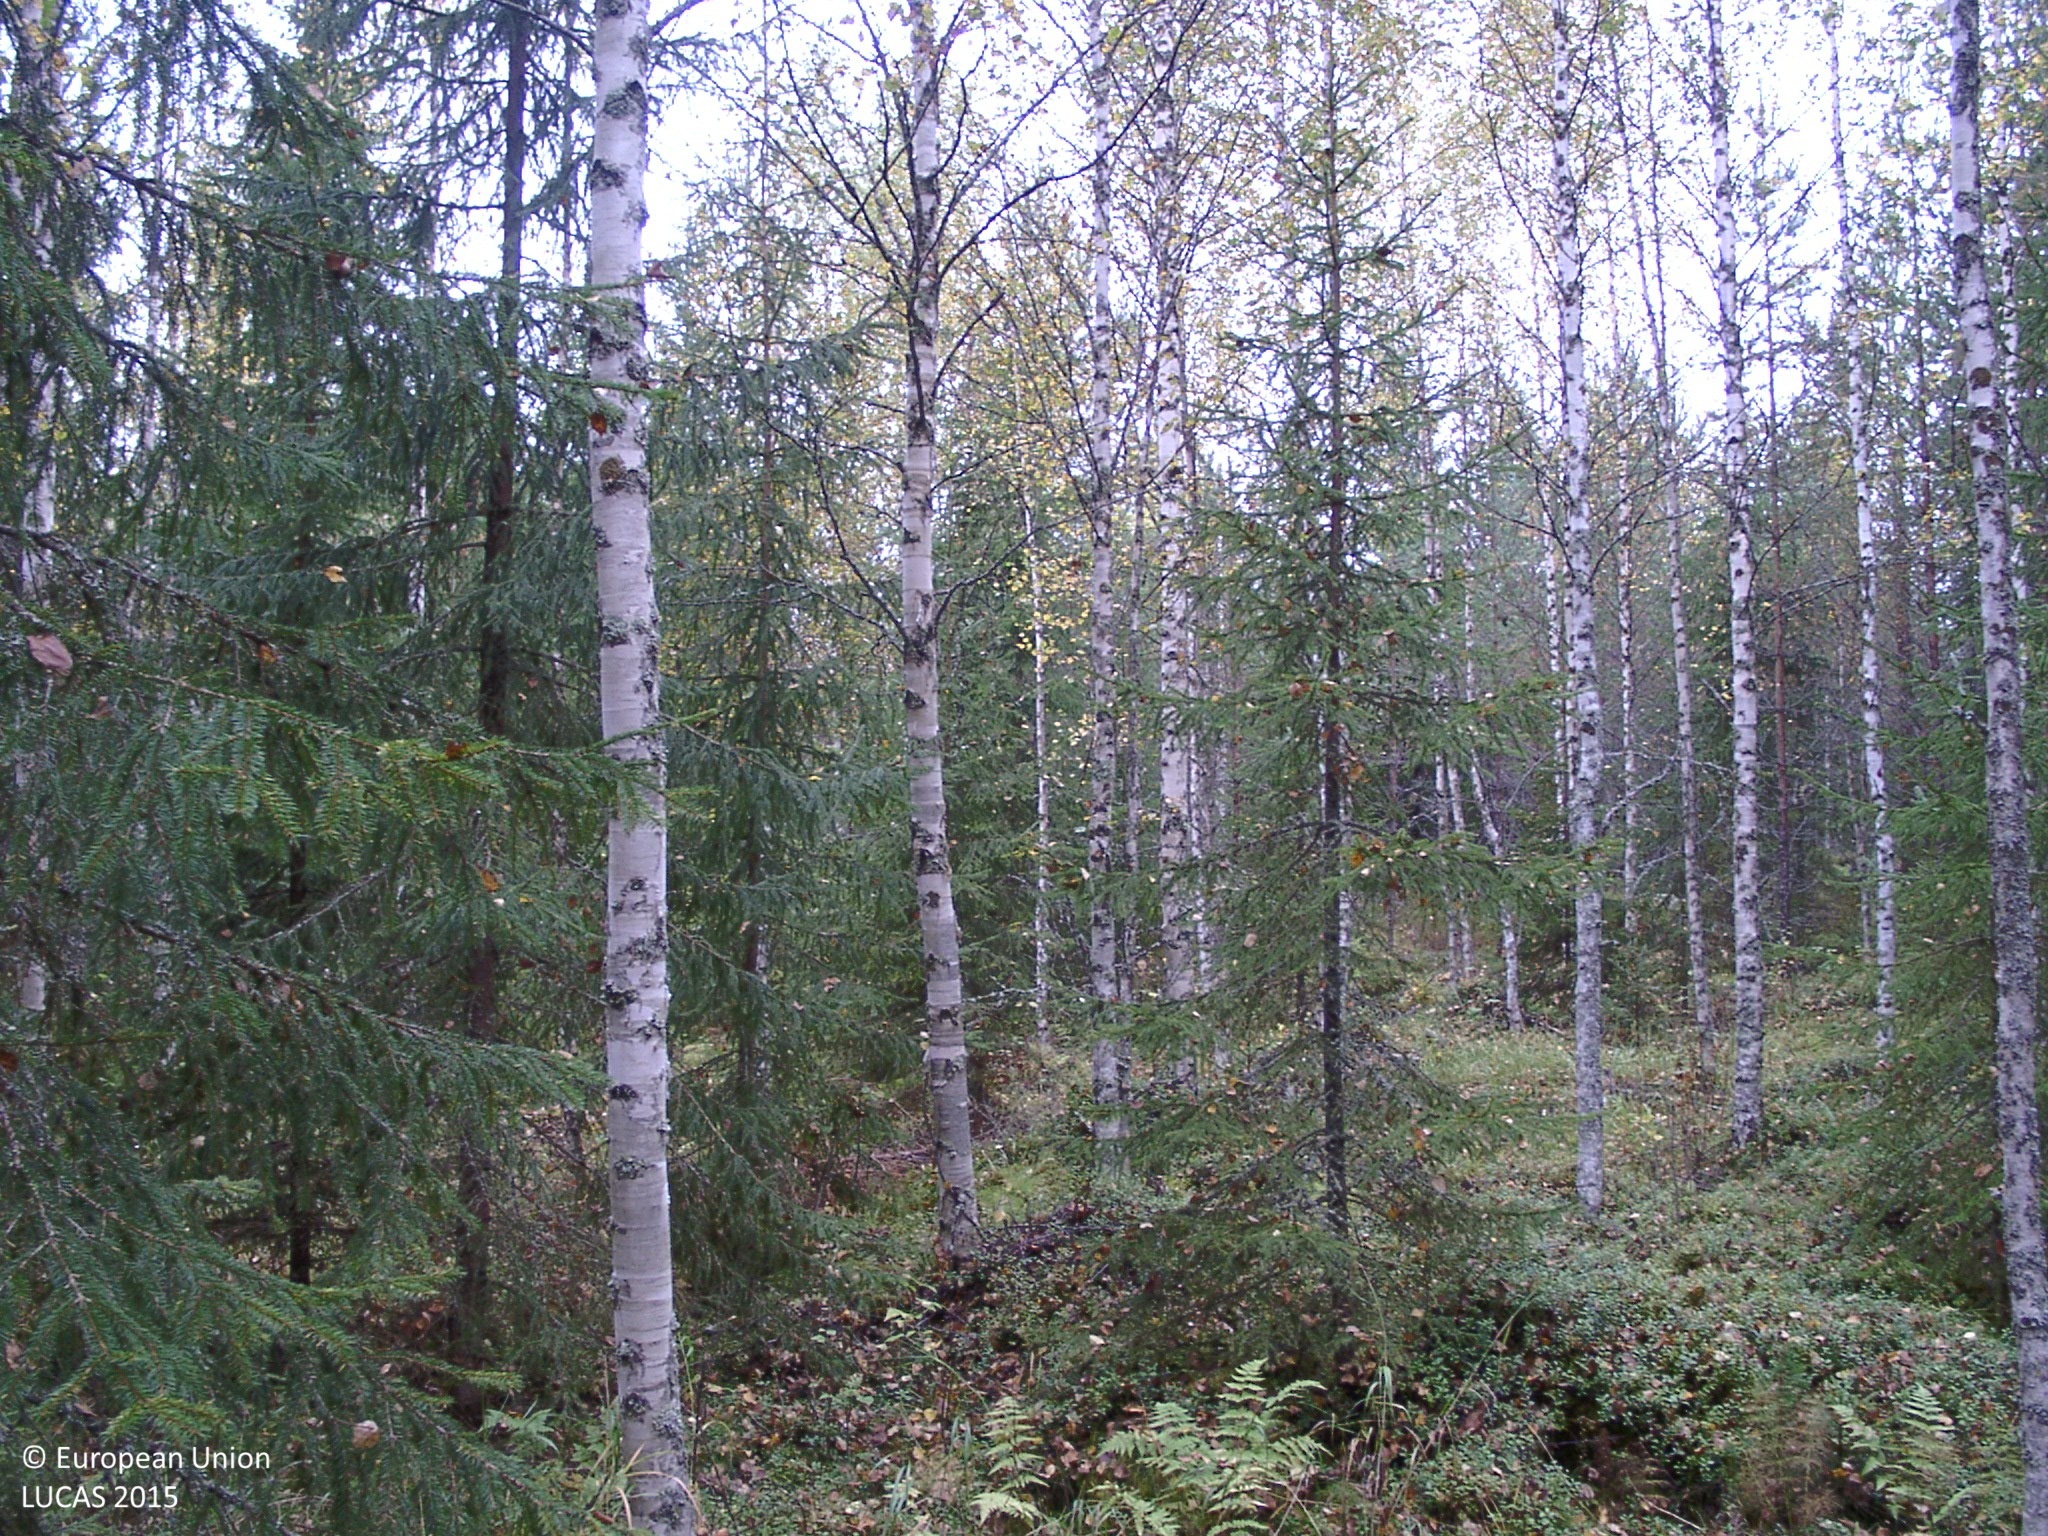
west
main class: Woodland
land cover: Other mixed woodland
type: boreal forest
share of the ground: 50 - 75 %
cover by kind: coniferous forest trees 45 %, broadleaved forest trees 25 %, shrubs 10 %, herbaceous plants 10 %, lichens and mosses 10 %
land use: Forestry
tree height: > 5 m
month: September
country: FI
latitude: 62.6831
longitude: 25.7217
